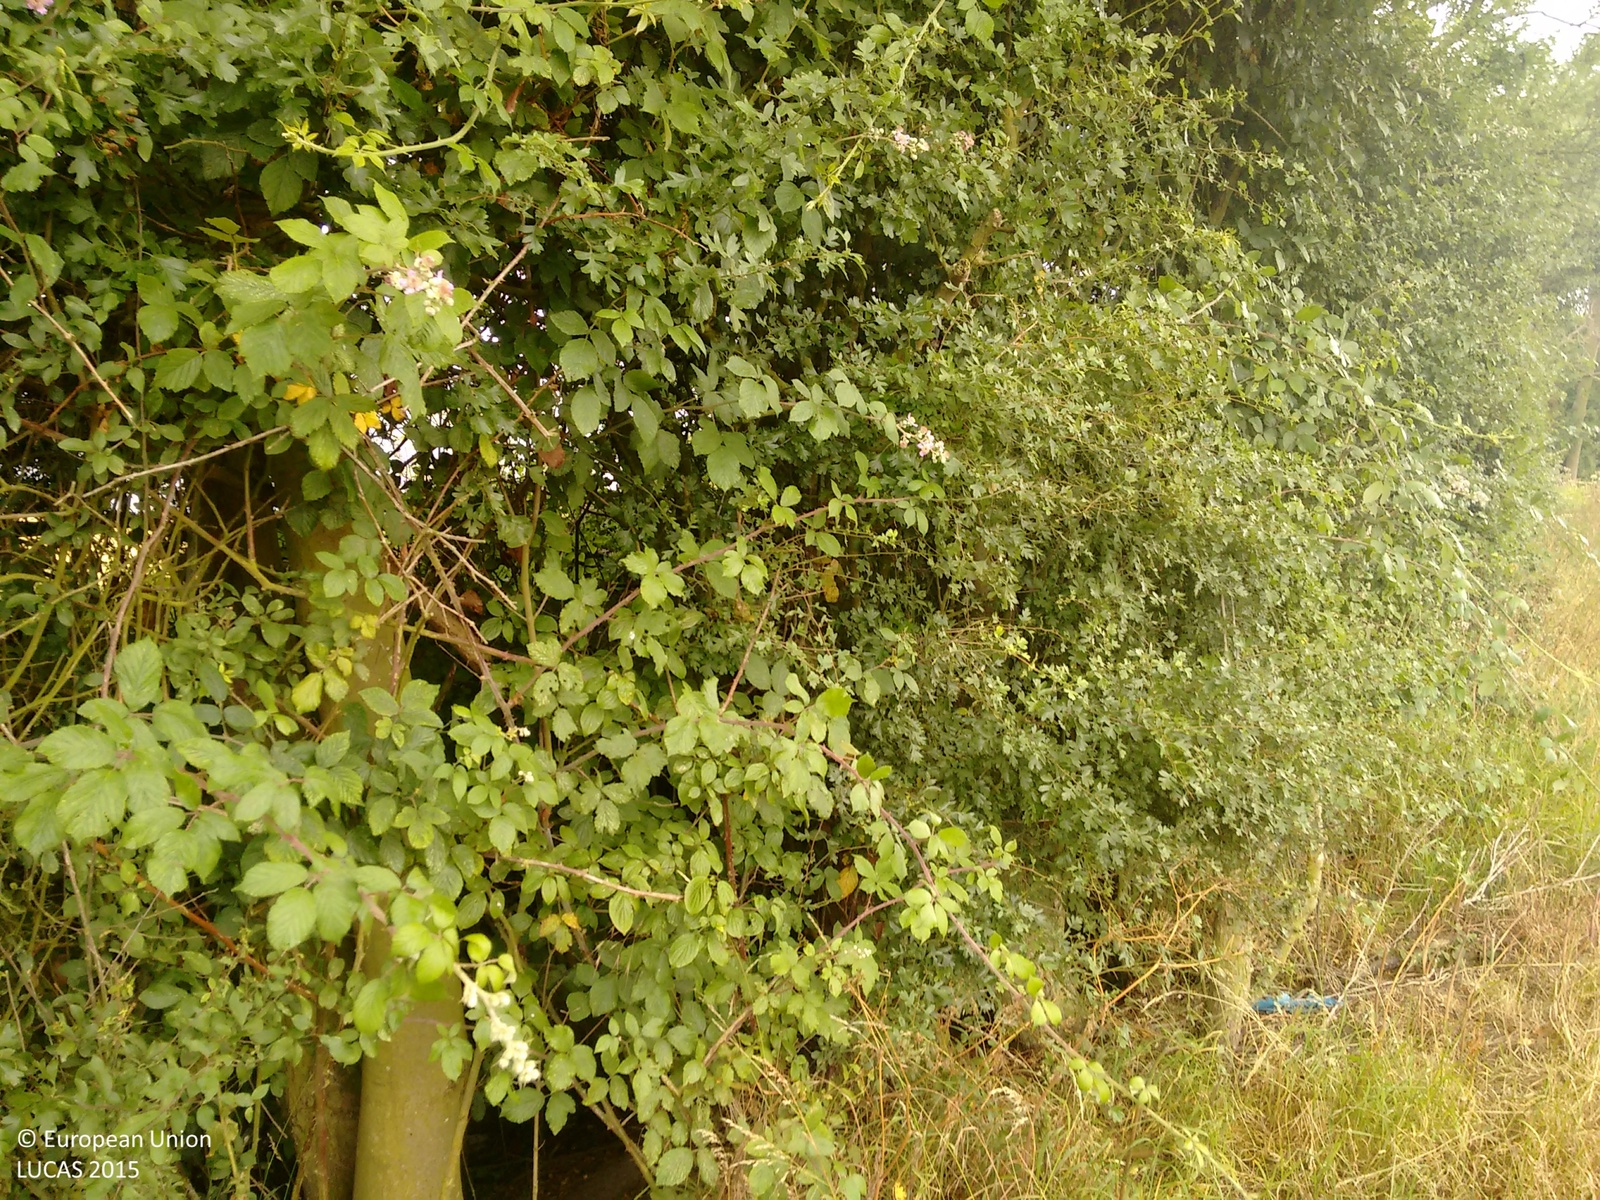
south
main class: Cropland
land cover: Common wheat
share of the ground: > 75 %
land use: Agriculture (excluding fallow land and kitchen gardens)
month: July
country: GB
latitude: 51.6390
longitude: 0.5661
